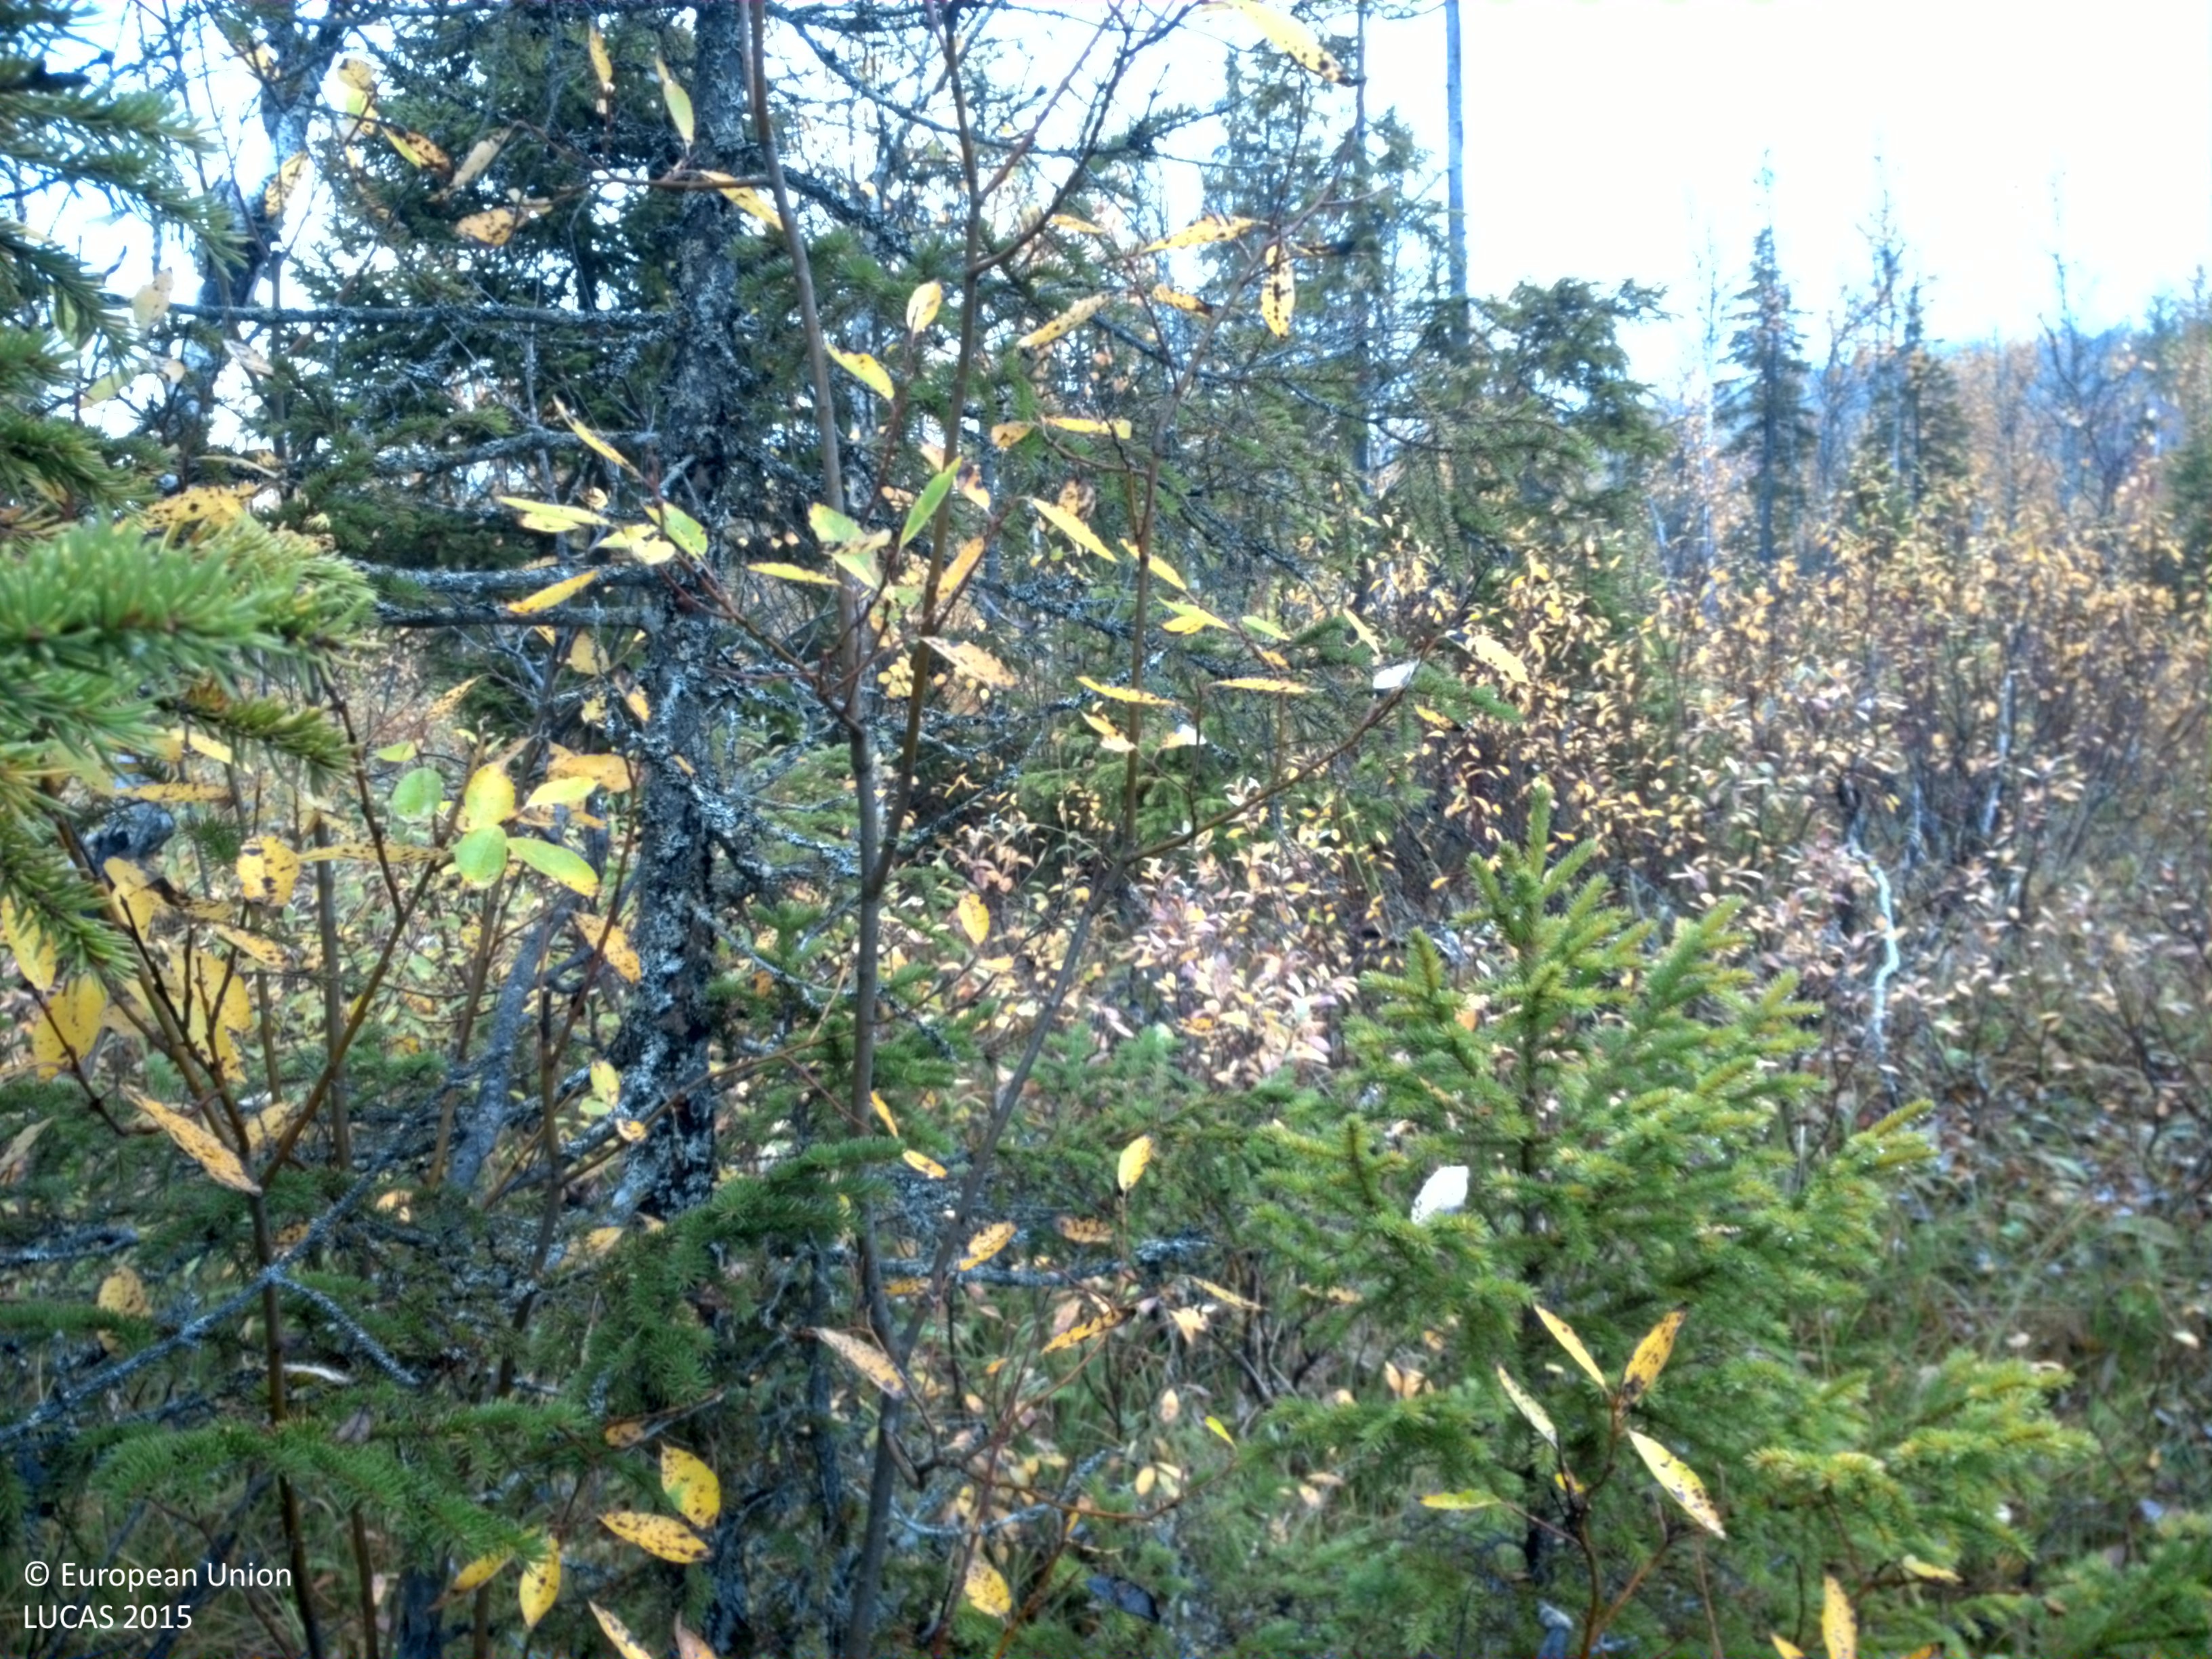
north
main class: Woodland
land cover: Spruce dominated mixed woodland
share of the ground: 10 - 25 %
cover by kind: herbaceous plants 45 %, shrubs 40 %, coniferous forest trees 5 %, broadleaved forest trees 5 %, lichens and mosses 5 %
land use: Forestry
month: September
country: SE
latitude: 65.0563
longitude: 16.6582
